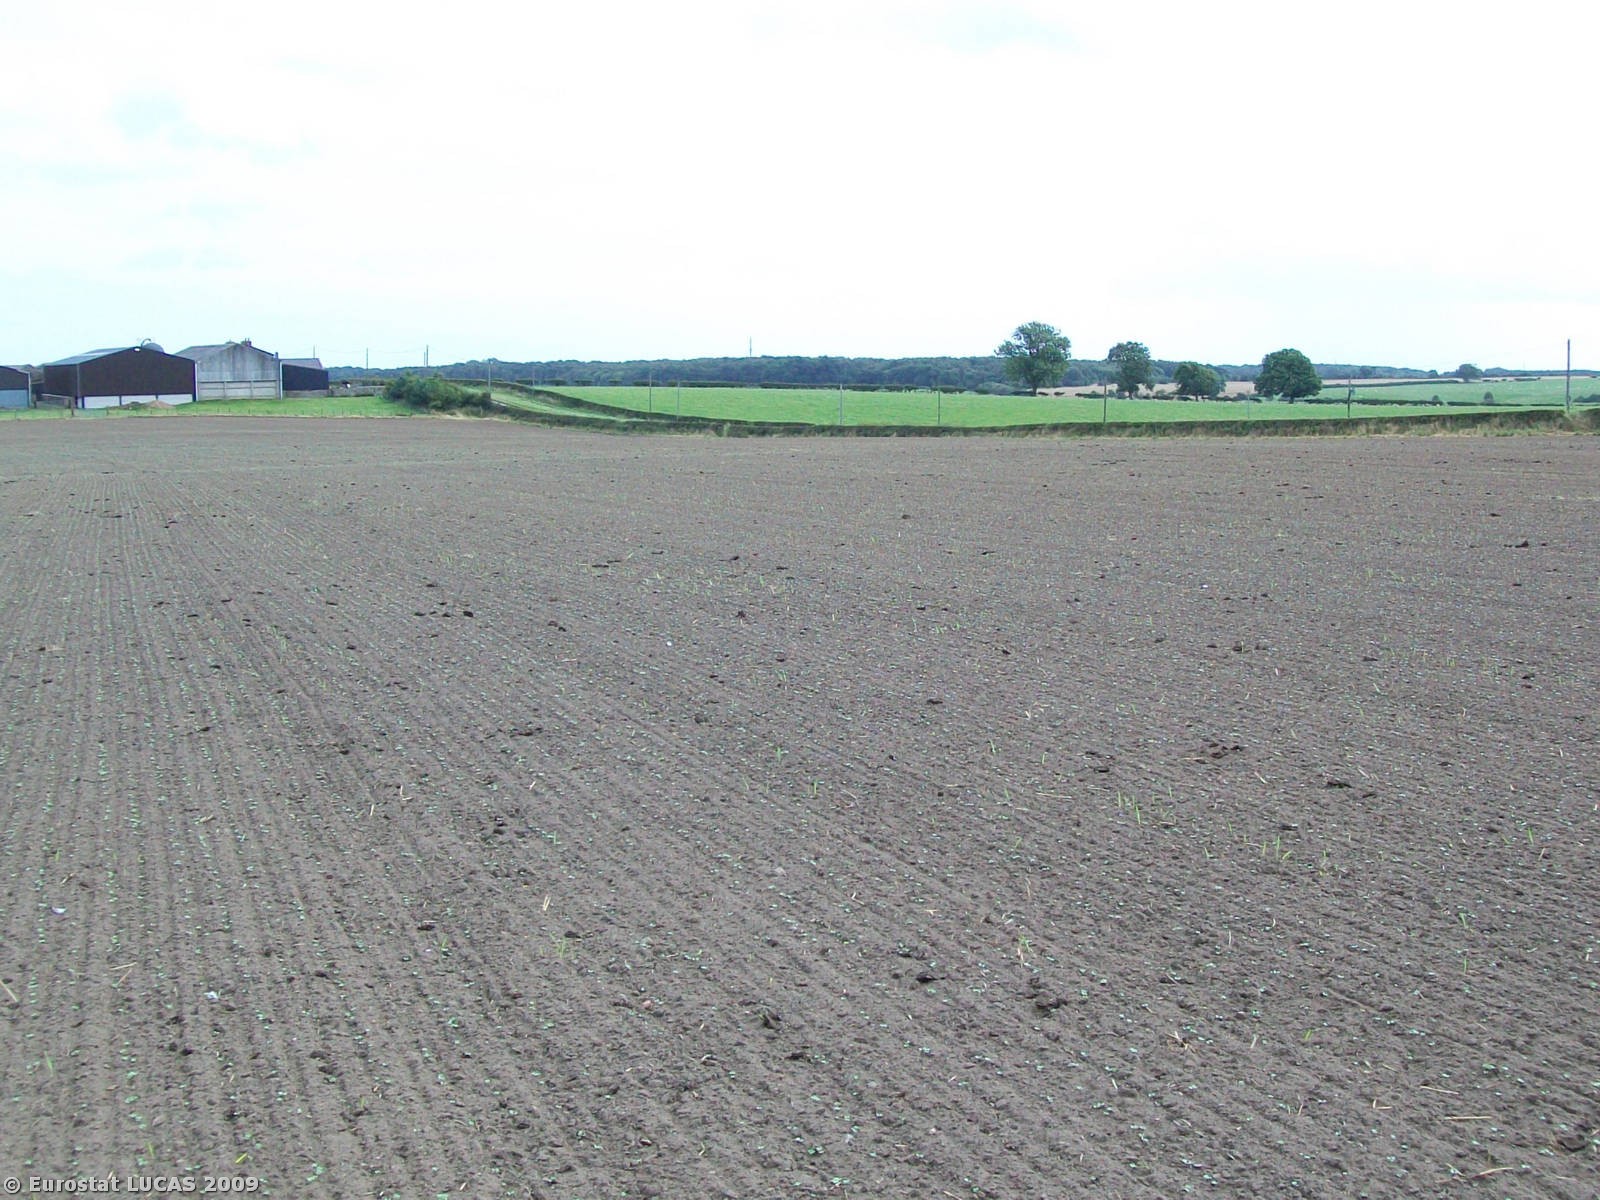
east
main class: Cropland
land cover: Rape and turnip rape
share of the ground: < 10 %
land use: Agriculture (excluding fallow land and kitchen gardens)
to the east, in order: Rape and turnip rape; Grass margins; Managed hedges; Grass margins; Artificial constructions in urban areas
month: August
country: GB
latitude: 55.1348
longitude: -1.7679
